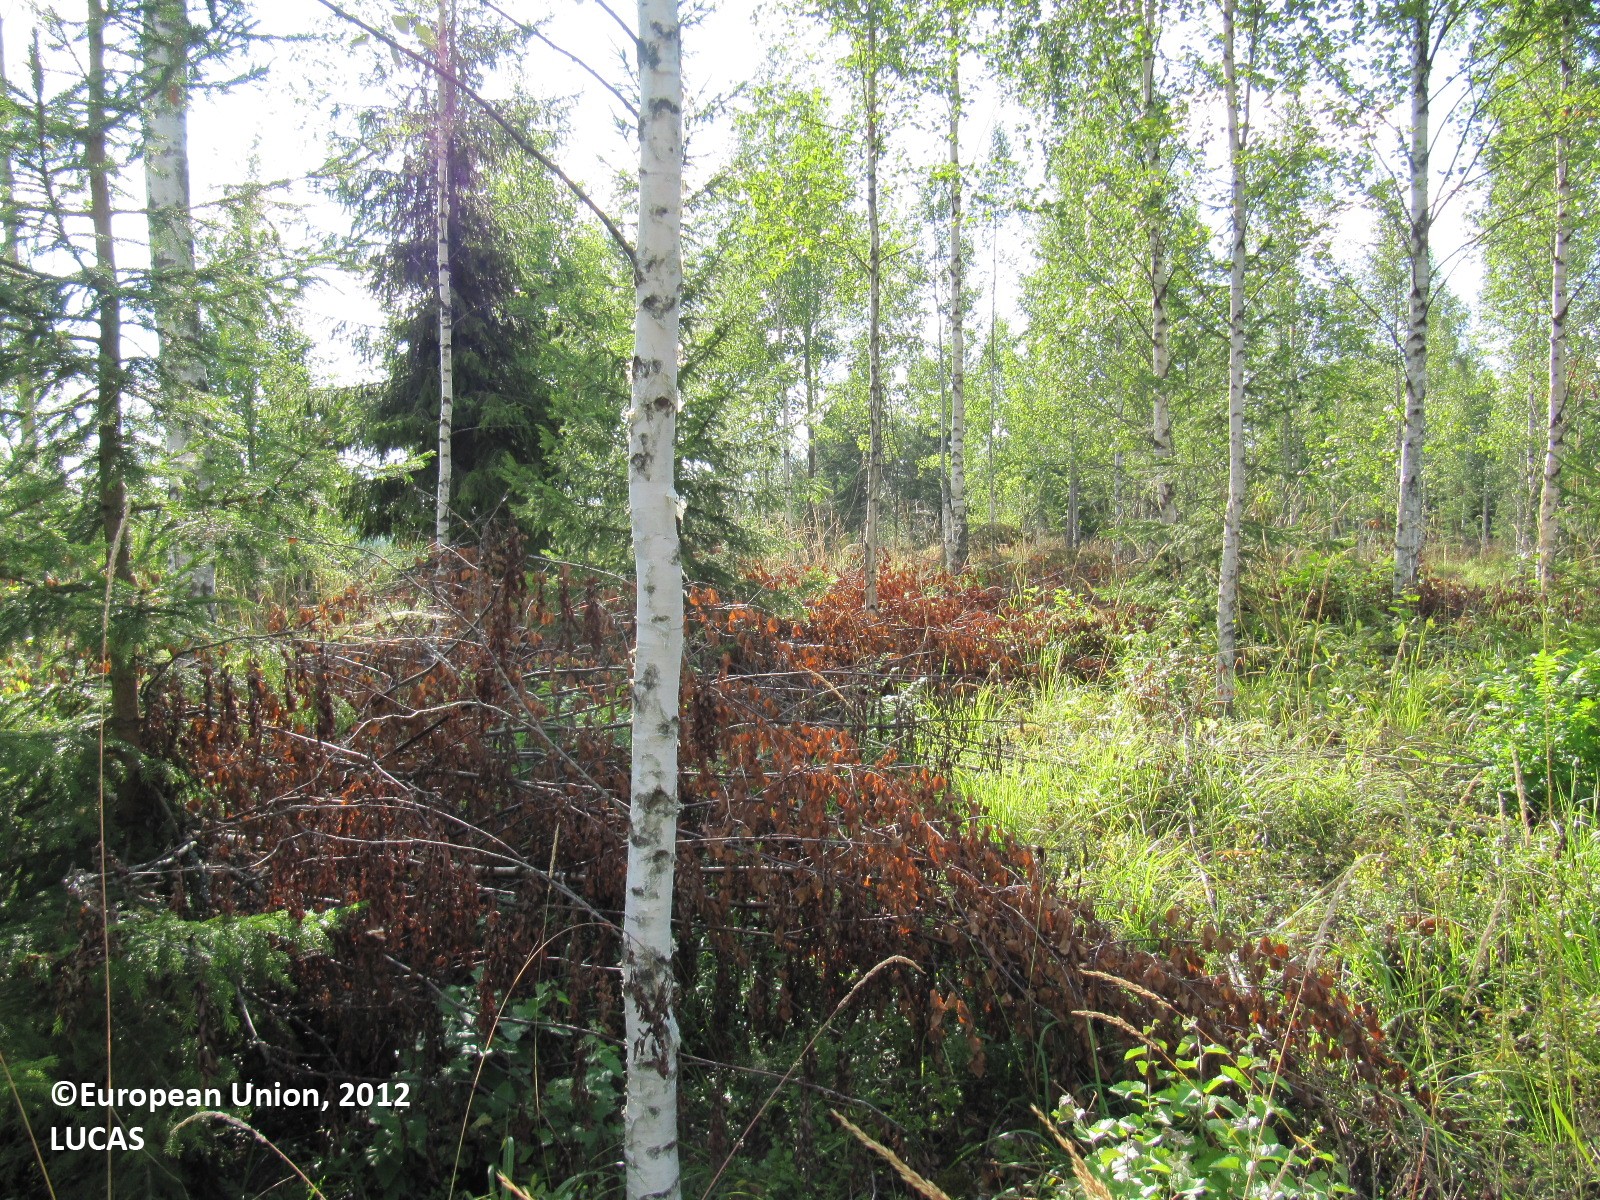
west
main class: Woodland
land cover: Other mixed woodland
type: boreal forest
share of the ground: 25 - 50 %
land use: Forestry
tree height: > 5 m
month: August
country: FI
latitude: 60.5953
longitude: 24.5496
